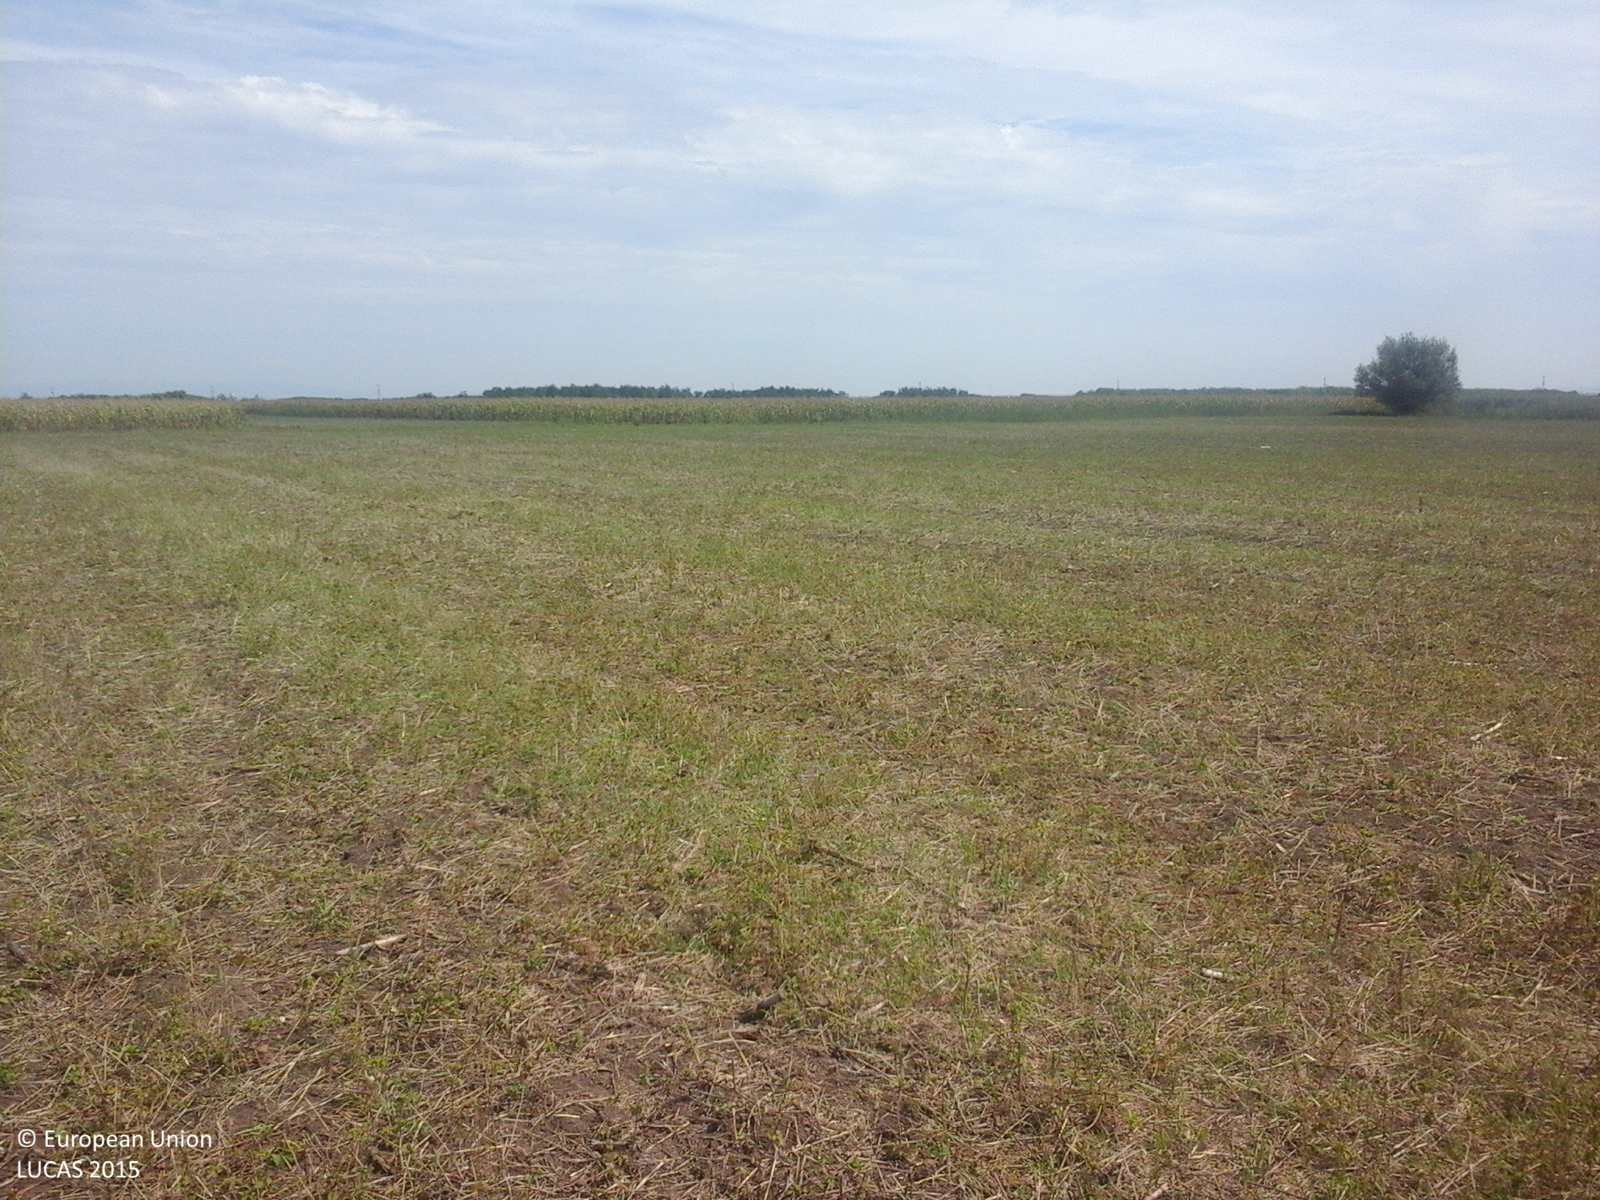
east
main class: Cropland
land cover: Durum wheat
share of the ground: 10 - 25 %
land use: Agriculture (excluding fallow land and kitchen gardens)
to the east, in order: Durum wheat; Maize
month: August
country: RO
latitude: 46.4225
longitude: 21.4744
